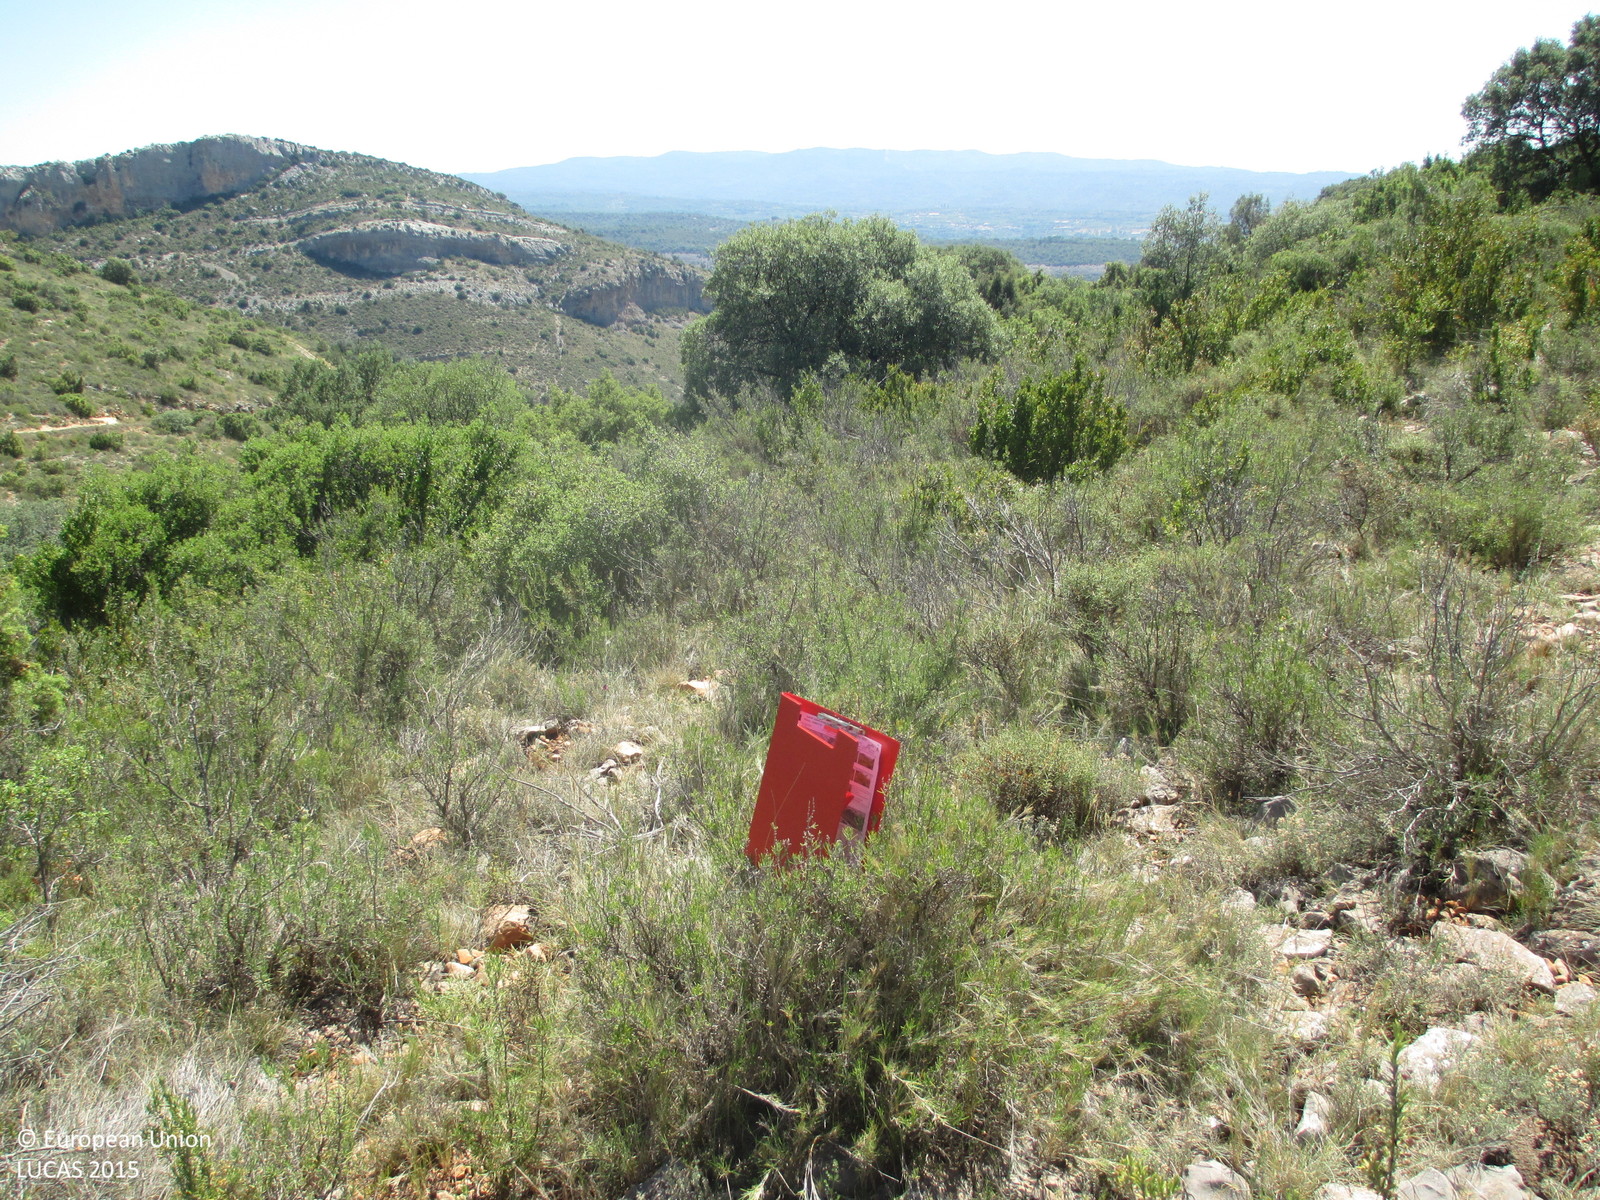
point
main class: Shrubland
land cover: Shrubland without tree cover
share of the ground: > 75 %
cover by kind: shrubs 95 %, herbaceous plants 5 %
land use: Semi-natural and natural areas not in use
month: June
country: ES
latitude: 42.1778
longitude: 0.0163
